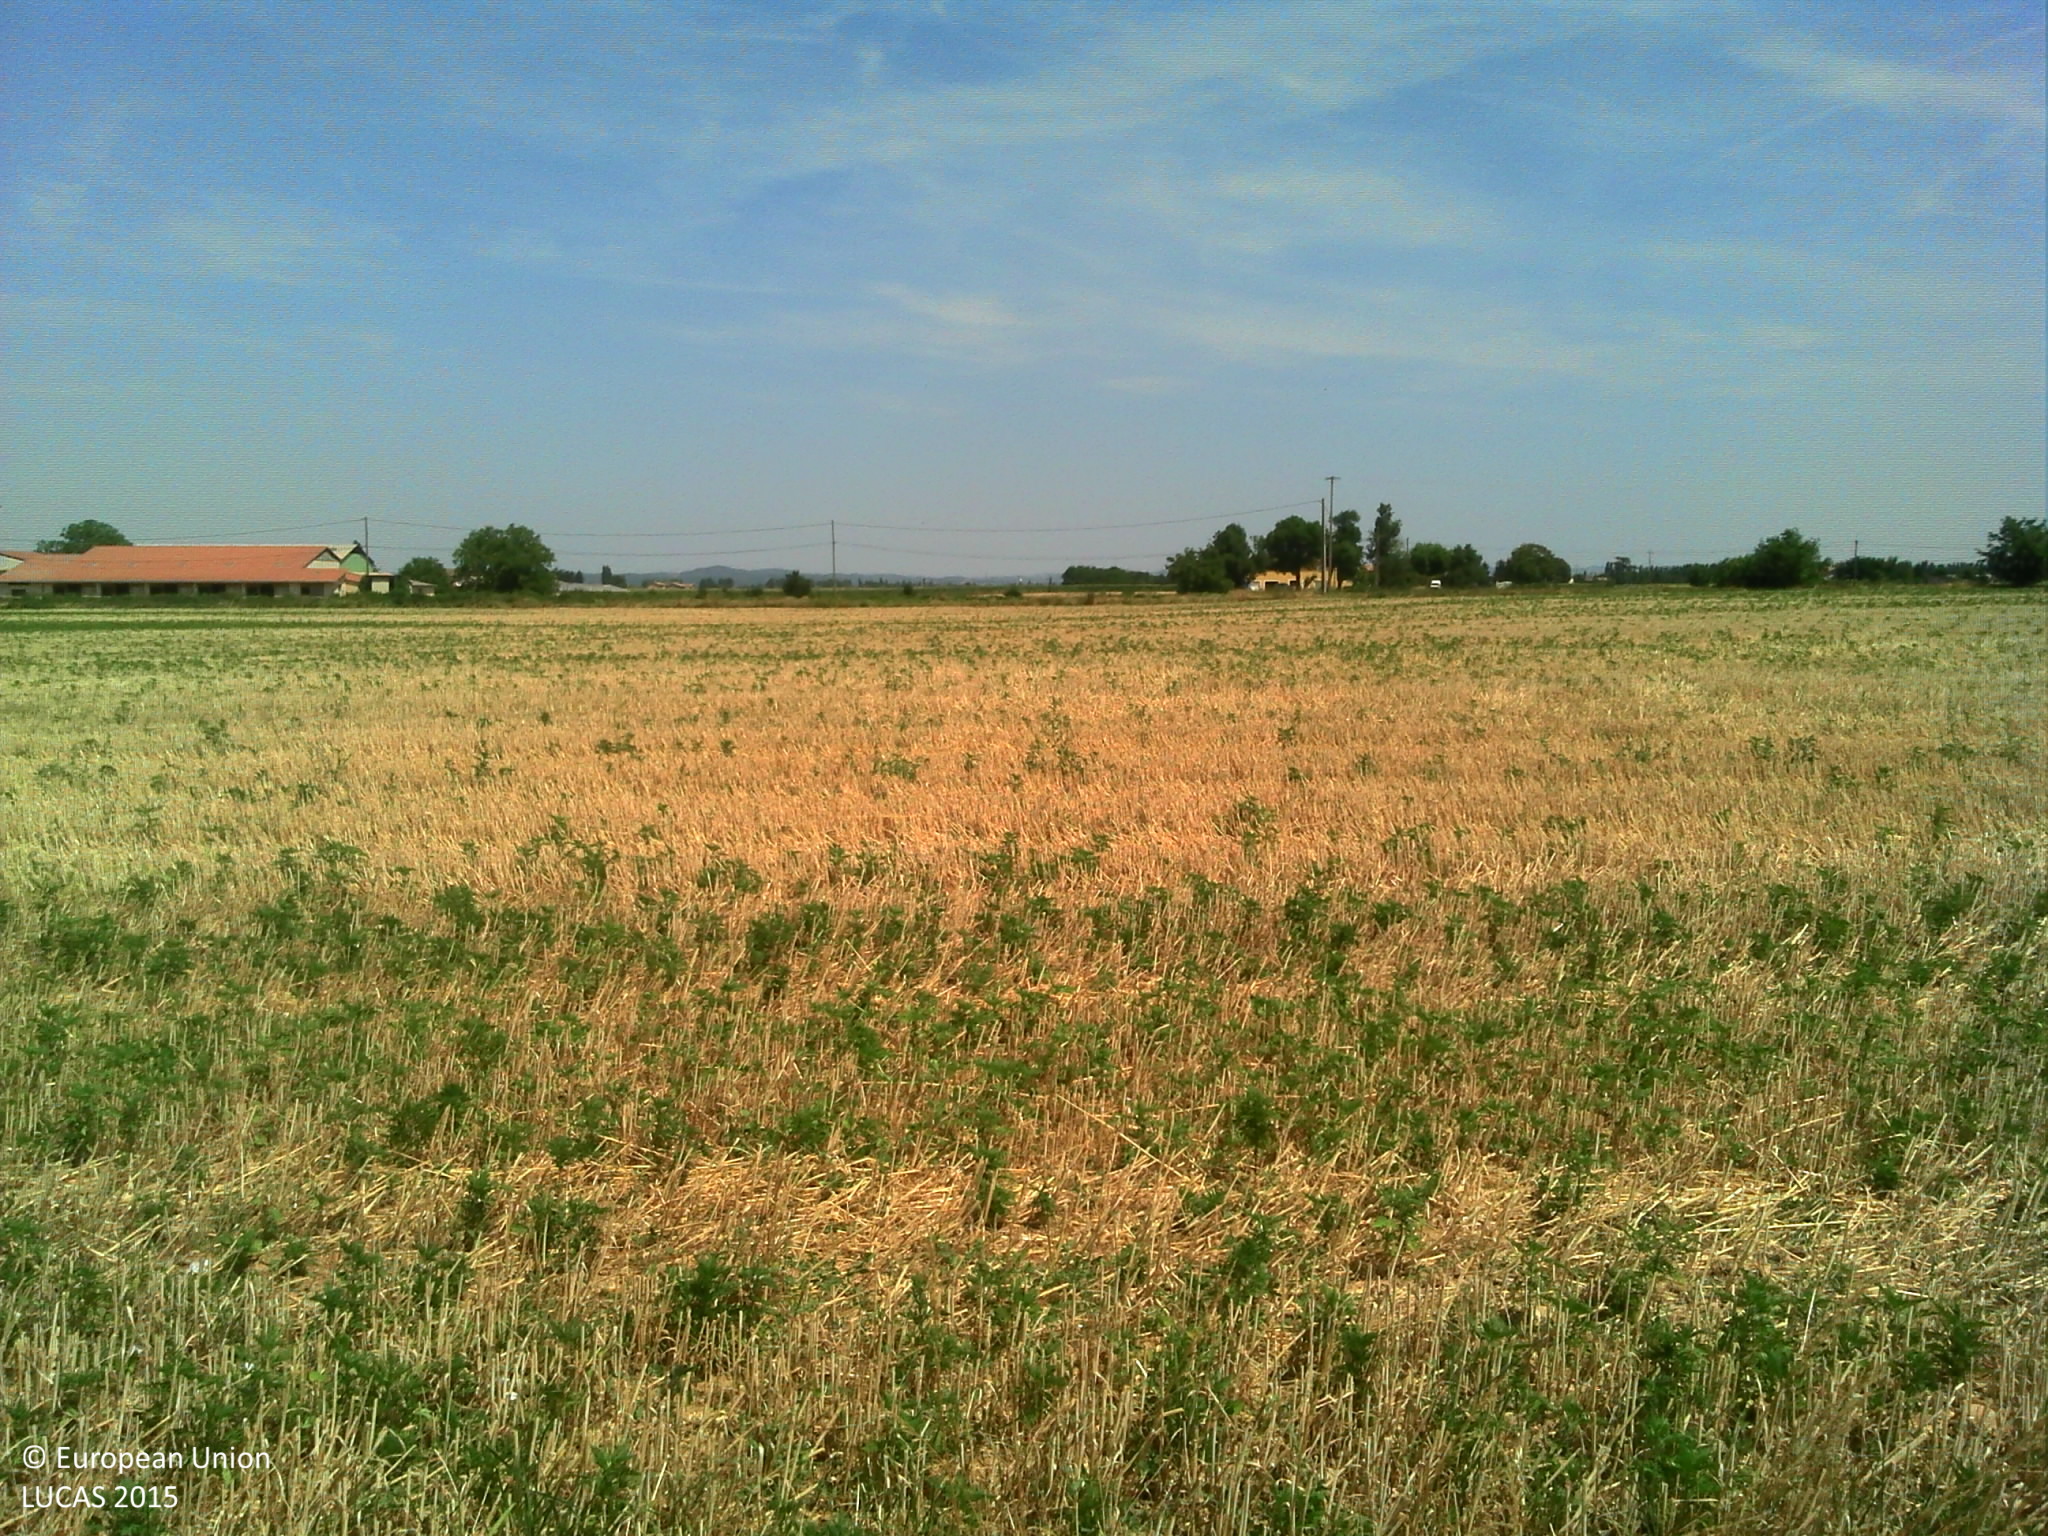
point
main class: Cropland
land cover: Barley
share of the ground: > 75 %
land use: Agriculture (excluding fallow land and kitchen gardens)
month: July
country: FR
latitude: 44.9897
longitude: 5.0210
